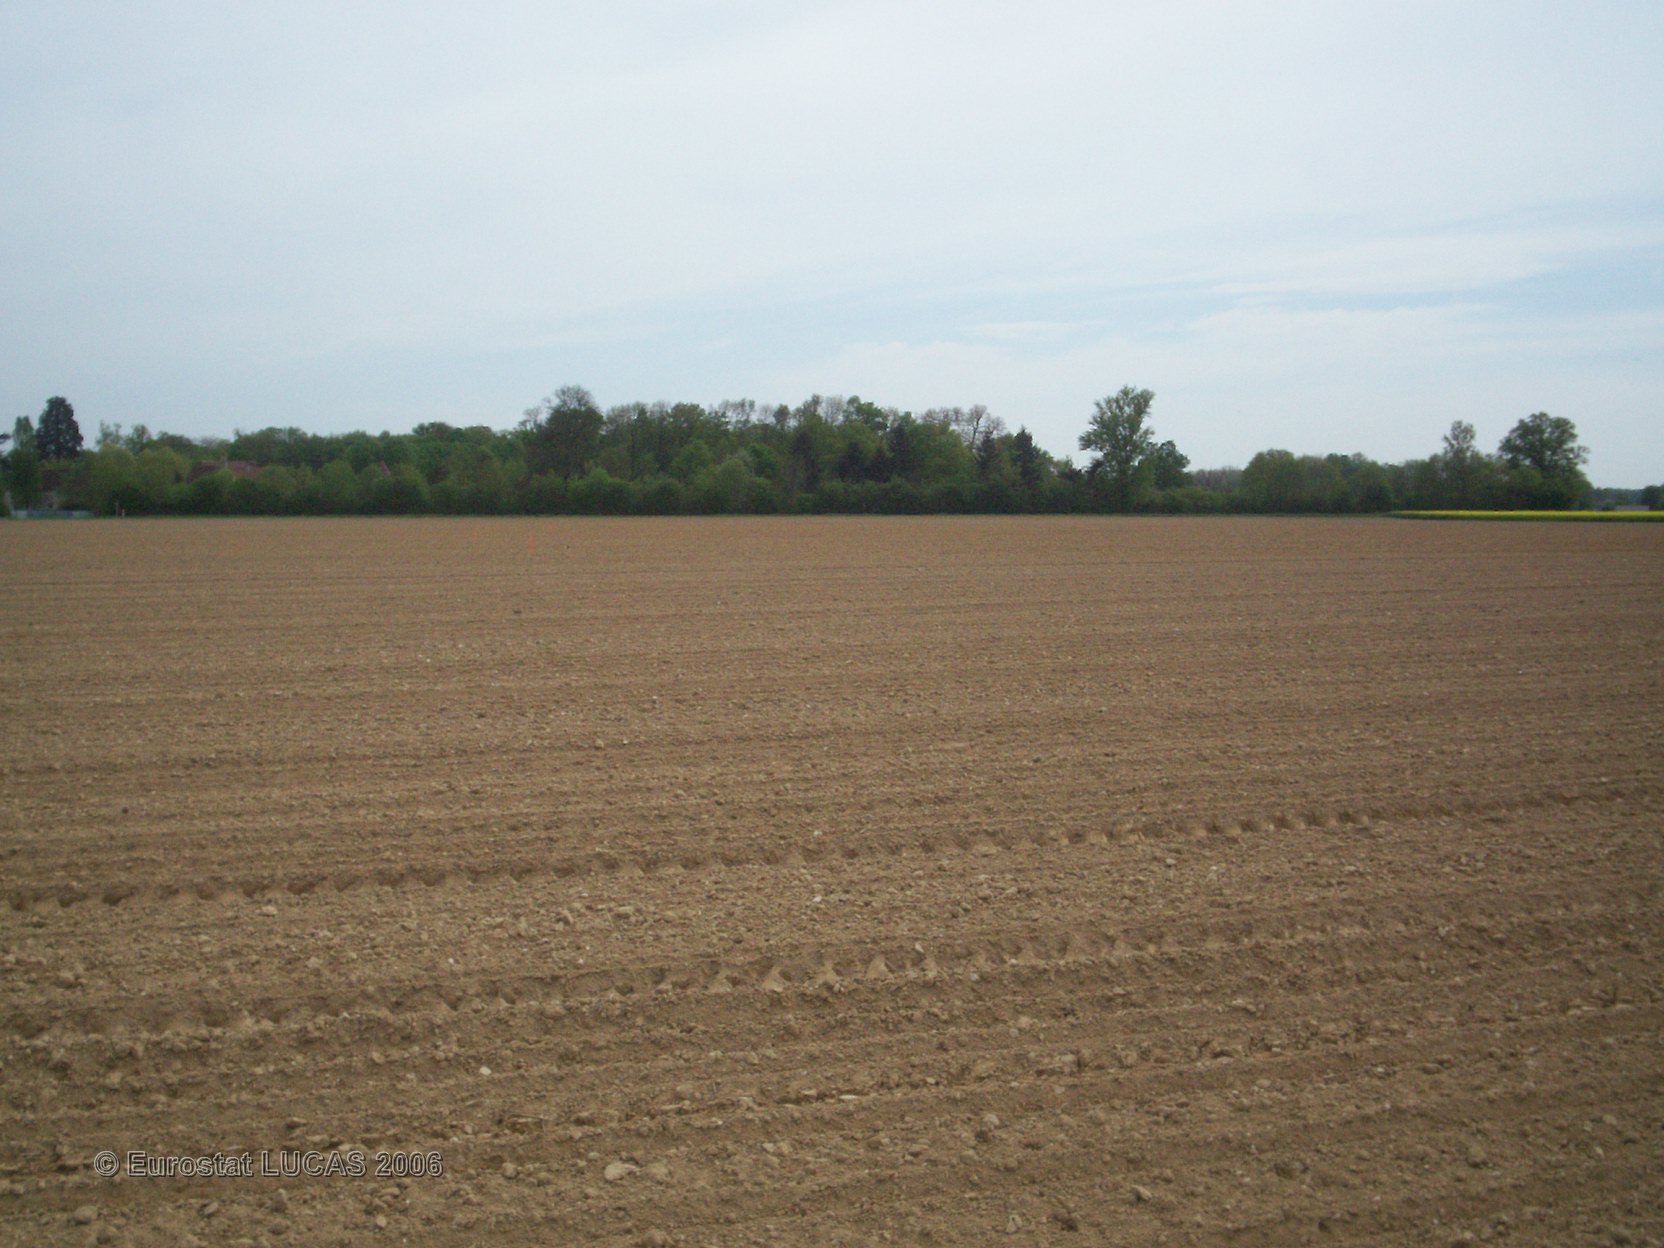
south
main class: Cropland
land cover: Sugar beet
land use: Agriculture (excluding fallow land and kitchen gardens)
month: May
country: FR
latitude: 48.7499
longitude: 2.8503
